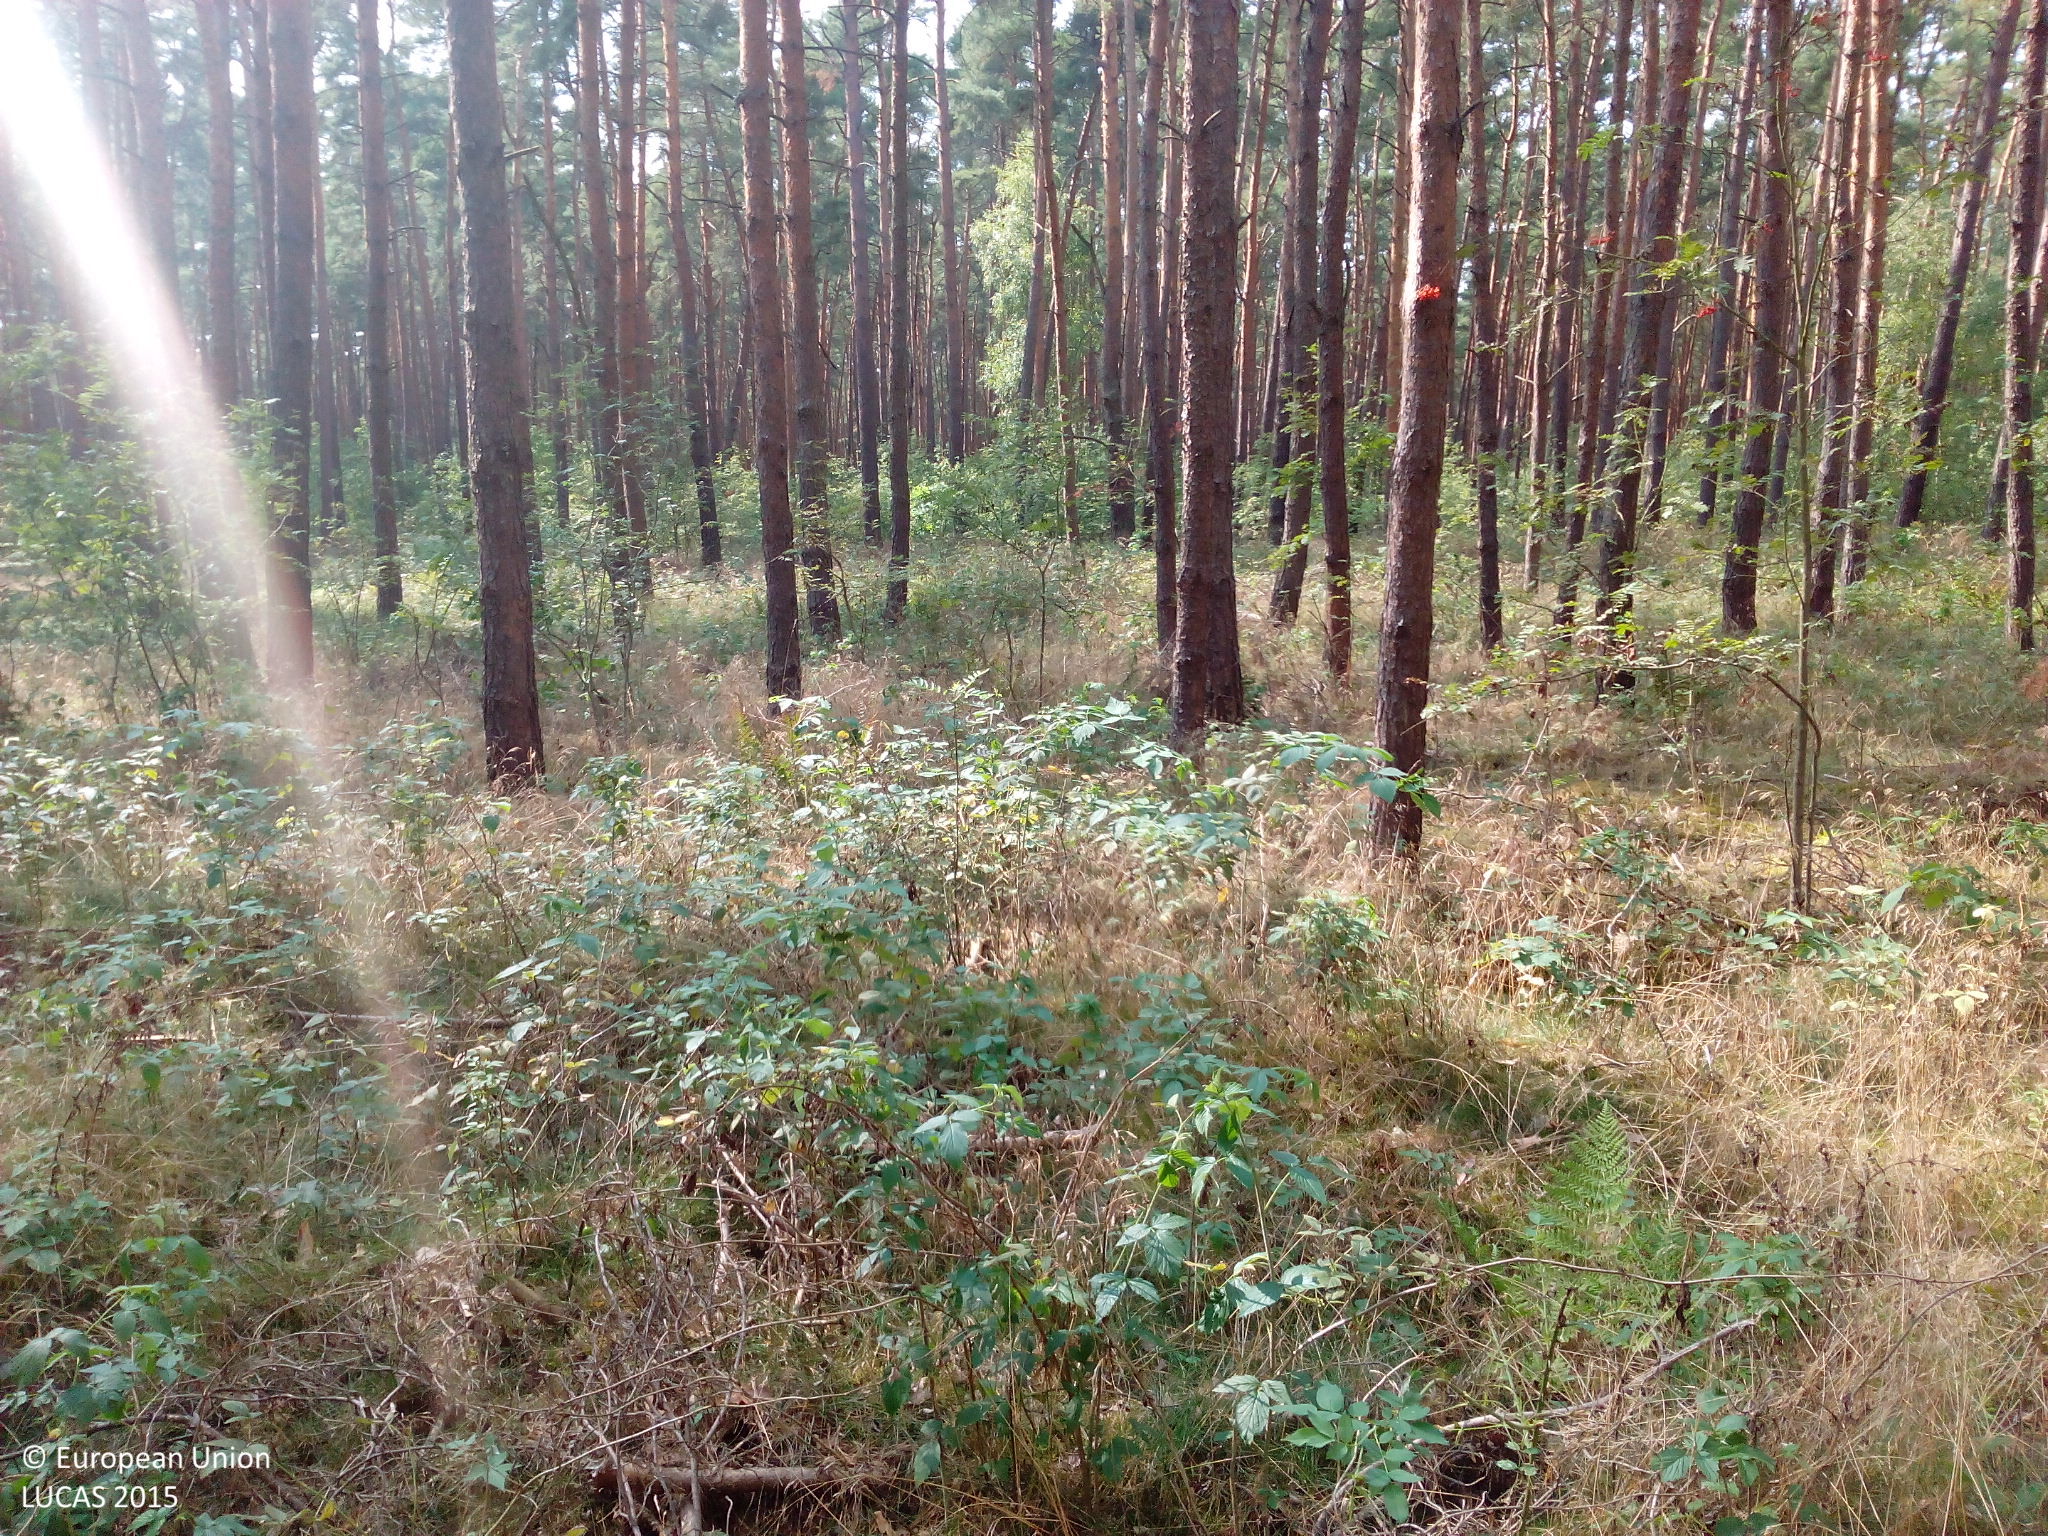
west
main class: Woodland
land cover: Pine dominated coniferous woodland
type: hemiboreal forest and nemoral coniferous forest and mixed broadleaved-coniferous forest
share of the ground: 50 - 75 %
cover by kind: coniferous forest trees 60 %, shrubs 20 %, herbaceous plants 10 %, lichens and mosses 10 %
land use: Forestry
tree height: > 5 m
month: August
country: DE
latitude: 52.8681
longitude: 11.7375
